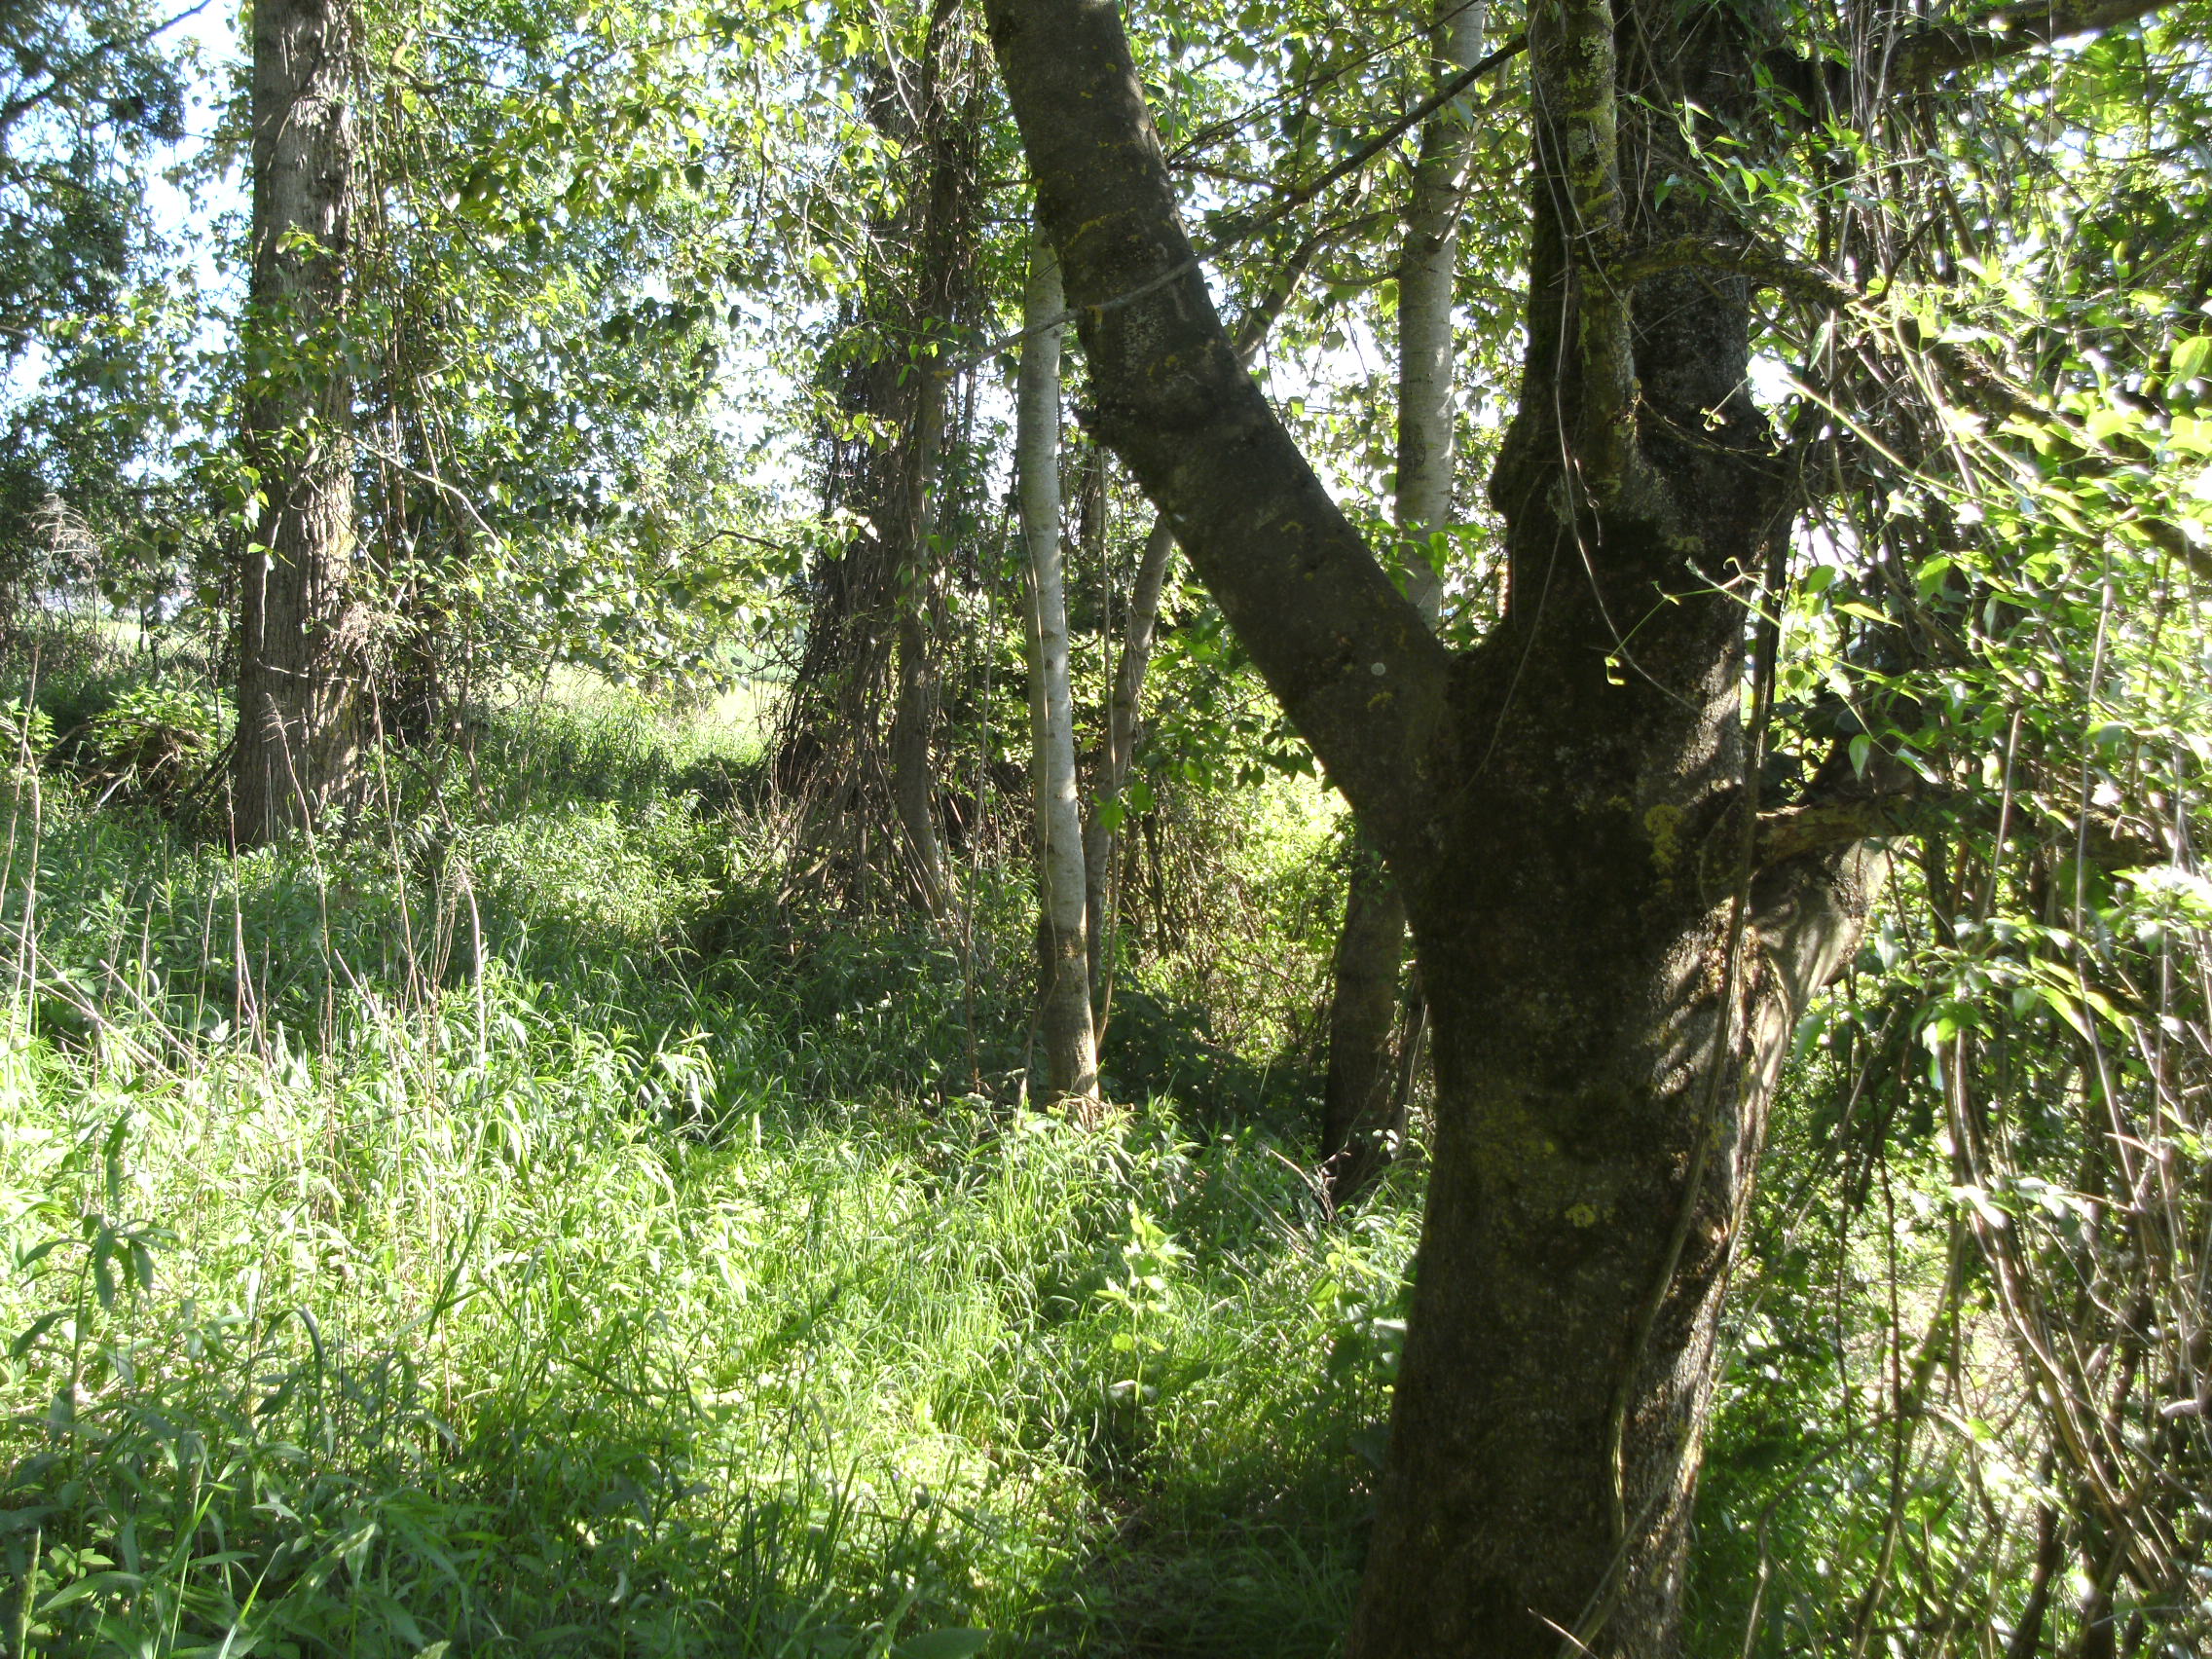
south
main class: Woodland
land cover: Broadleaved woodland
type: mesophytic deciduous forest
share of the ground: > 75 %
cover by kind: broadleaved forest trees 80 %, herbaceous plants 20 %
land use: Semi-natural and natural areas not in use
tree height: > 5 m
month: May
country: AT
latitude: 48.3070
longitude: 14.1661
